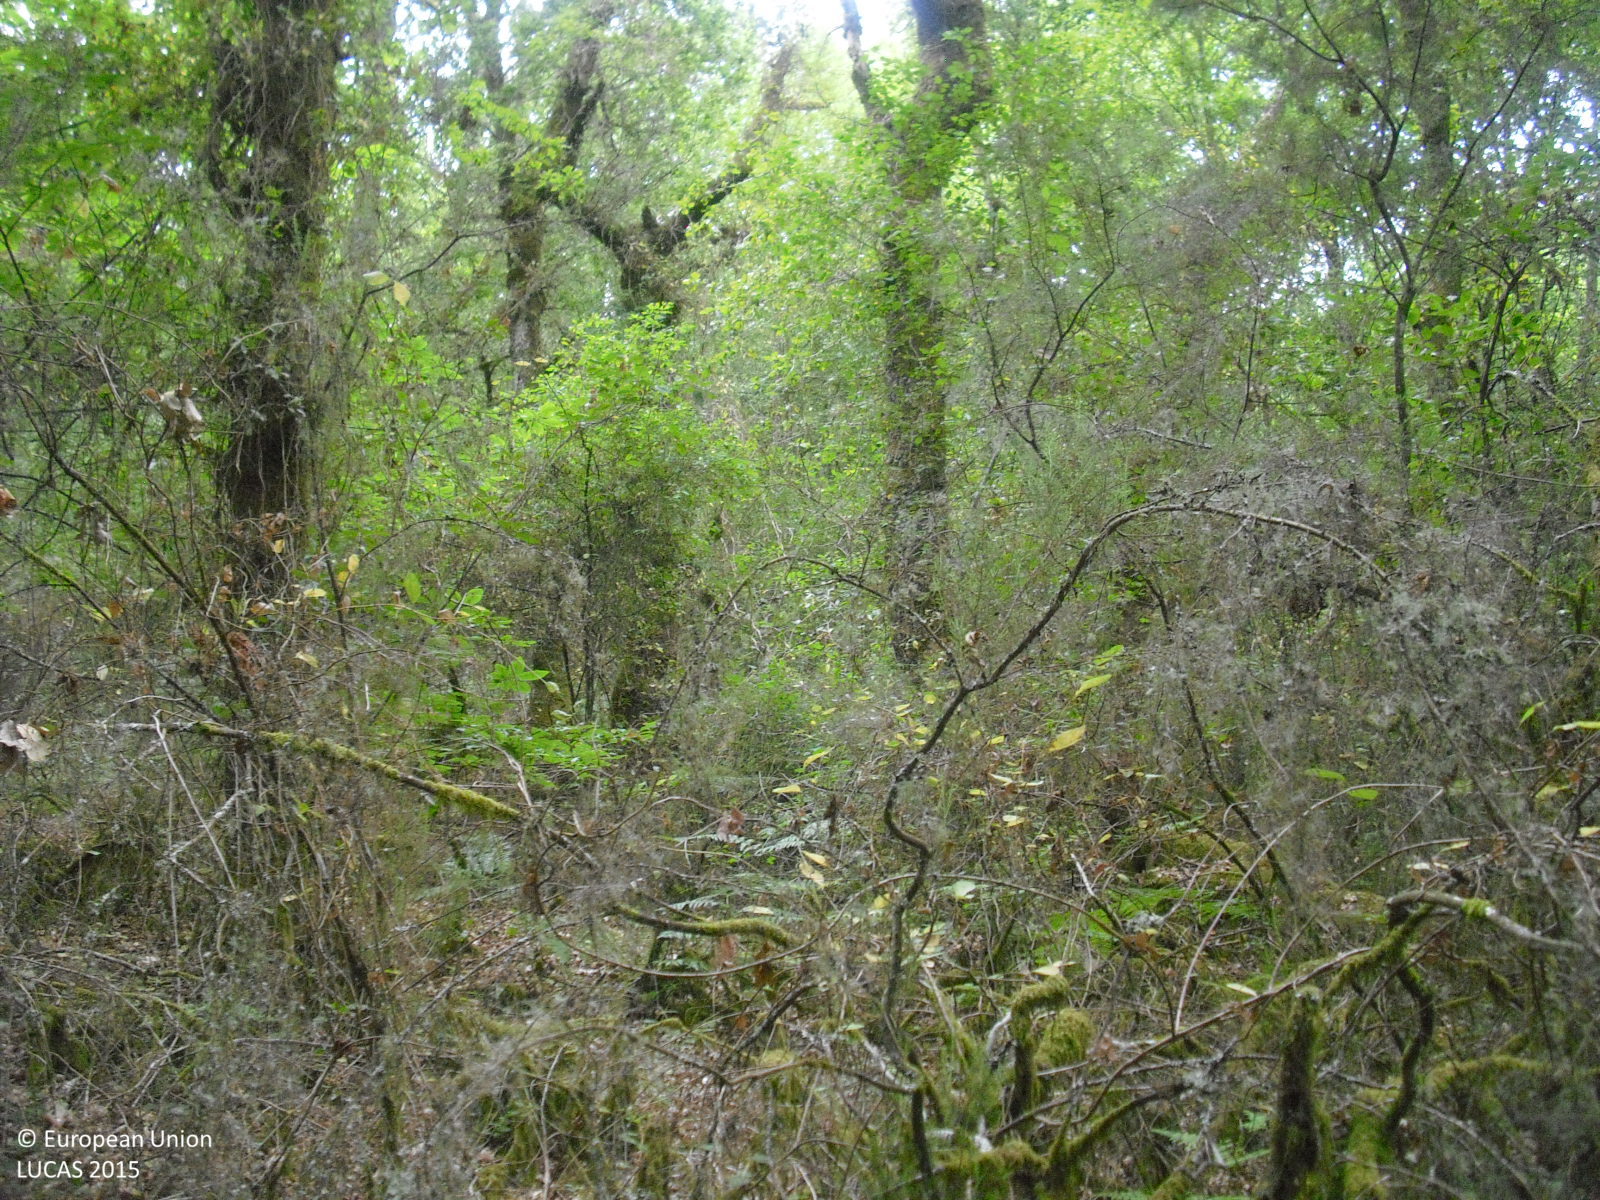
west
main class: Woodland
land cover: Broadleaved woodland
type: thermophilous deciduous forest
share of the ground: > 75 %
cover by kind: broadleaved forest trees 90 %, shrubs 10 %
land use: Semi-natural and natural areas not in use
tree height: > 5 m
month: July
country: ES
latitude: 42.3811
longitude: -7.6462
